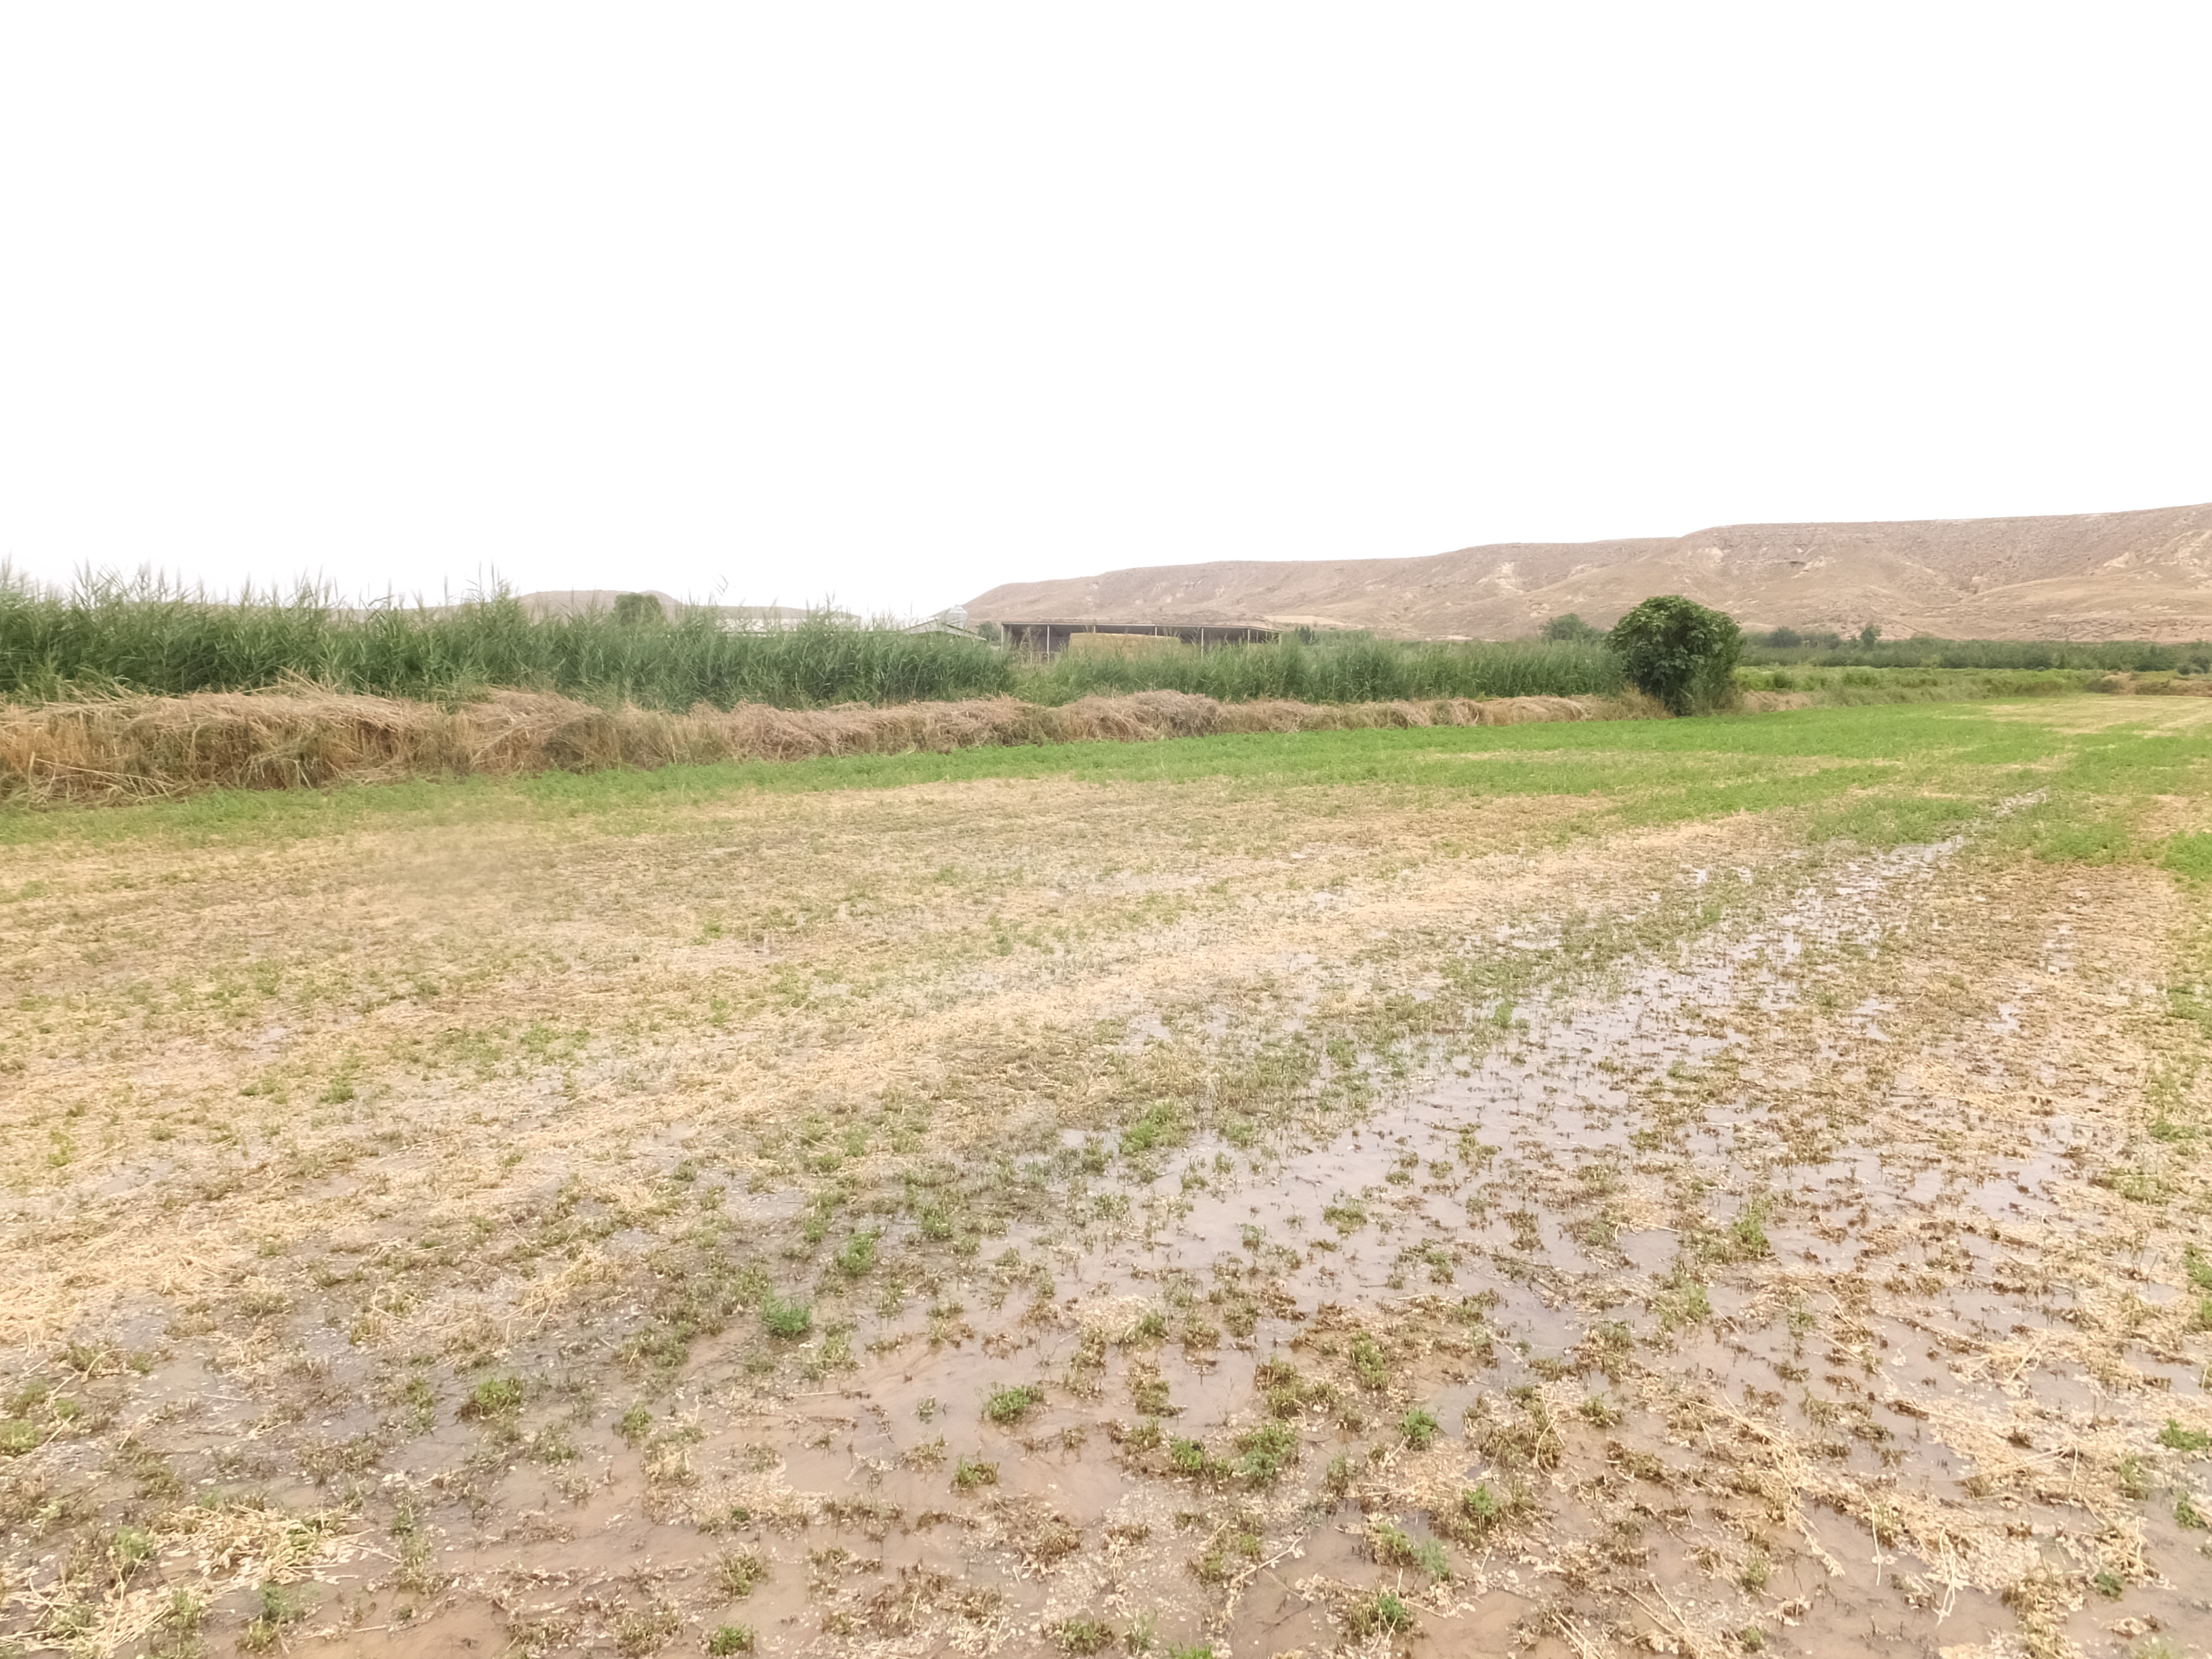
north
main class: Cropland
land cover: Lucerne
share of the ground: > 75 %
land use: Agriculture (excluding fallow land and kitchen gardens)
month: July
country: ES
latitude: 41.6635
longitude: 0.1489
